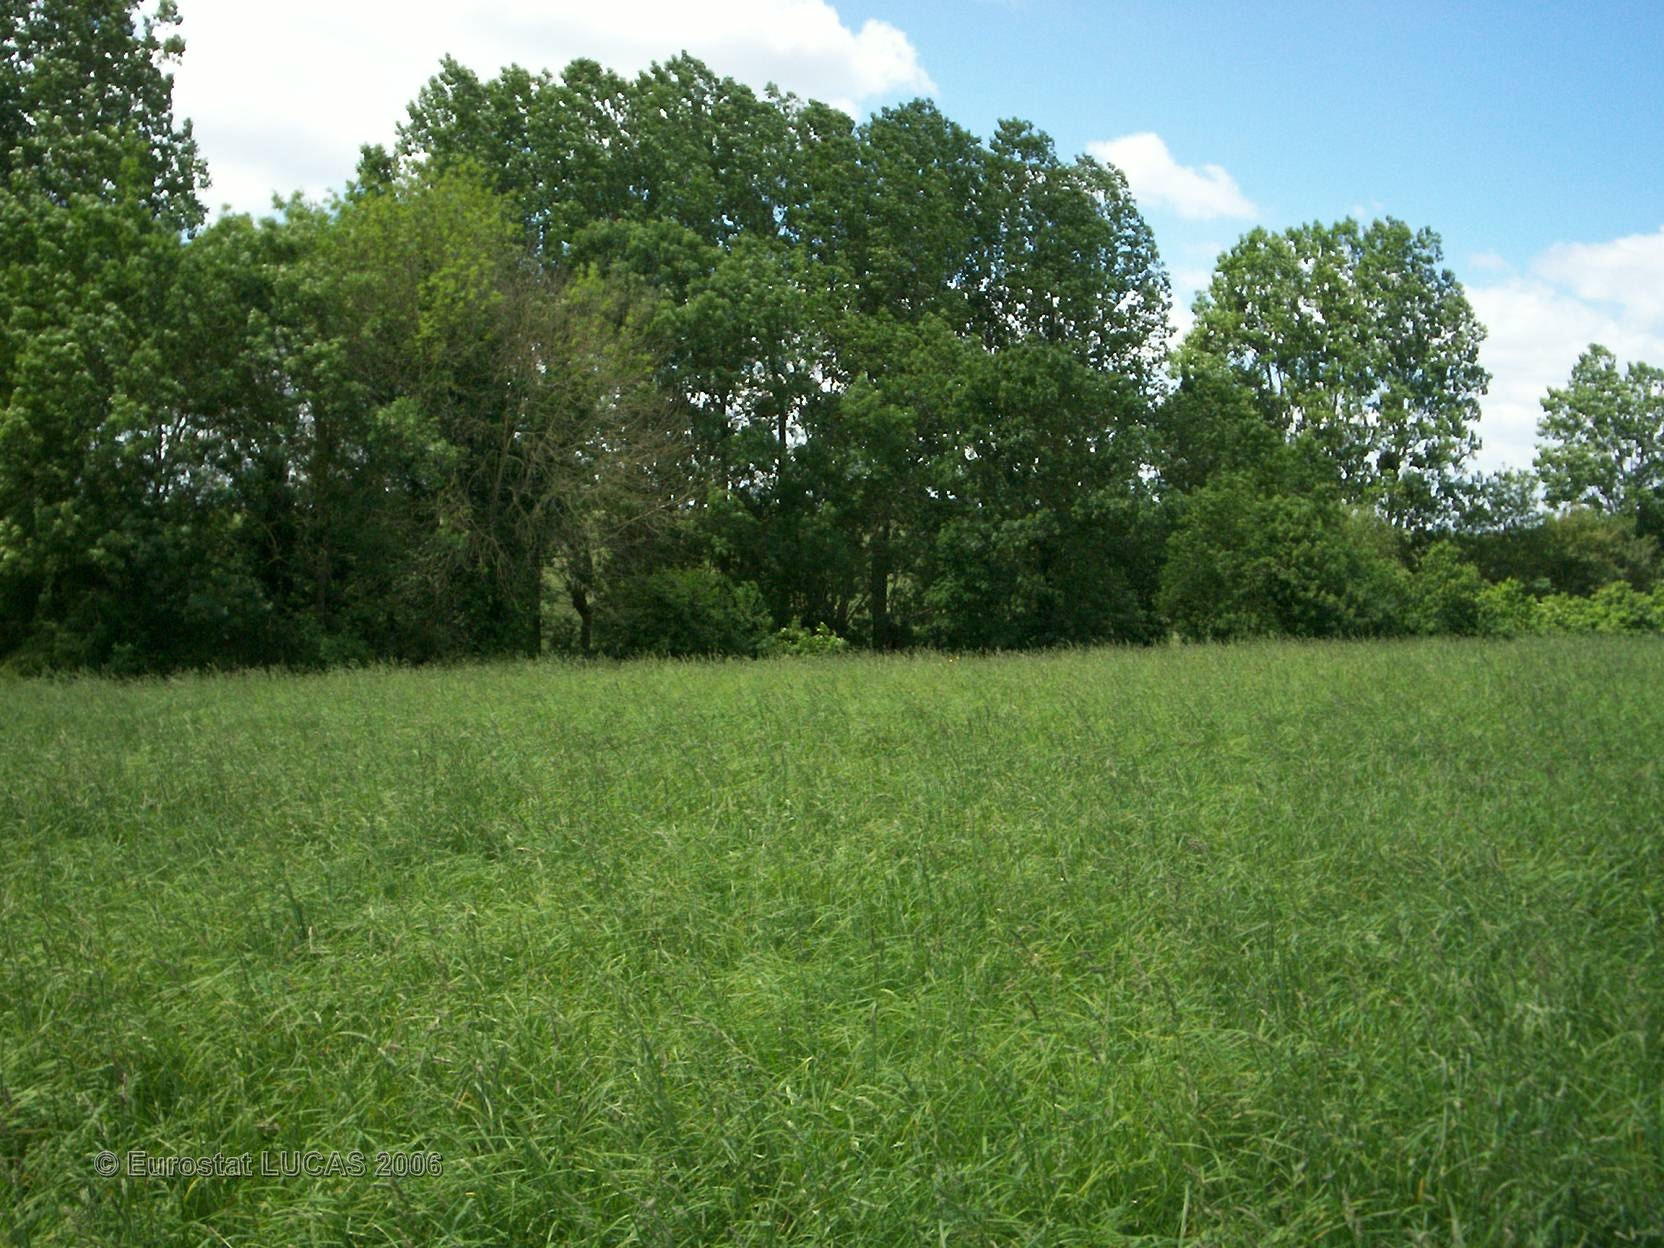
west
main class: Grassland
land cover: Grassland without tree/shrub cover
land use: Agriculture (excluding fallow land and kitchen gardens)
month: May
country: FR
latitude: 47.4421
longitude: -1.1103
